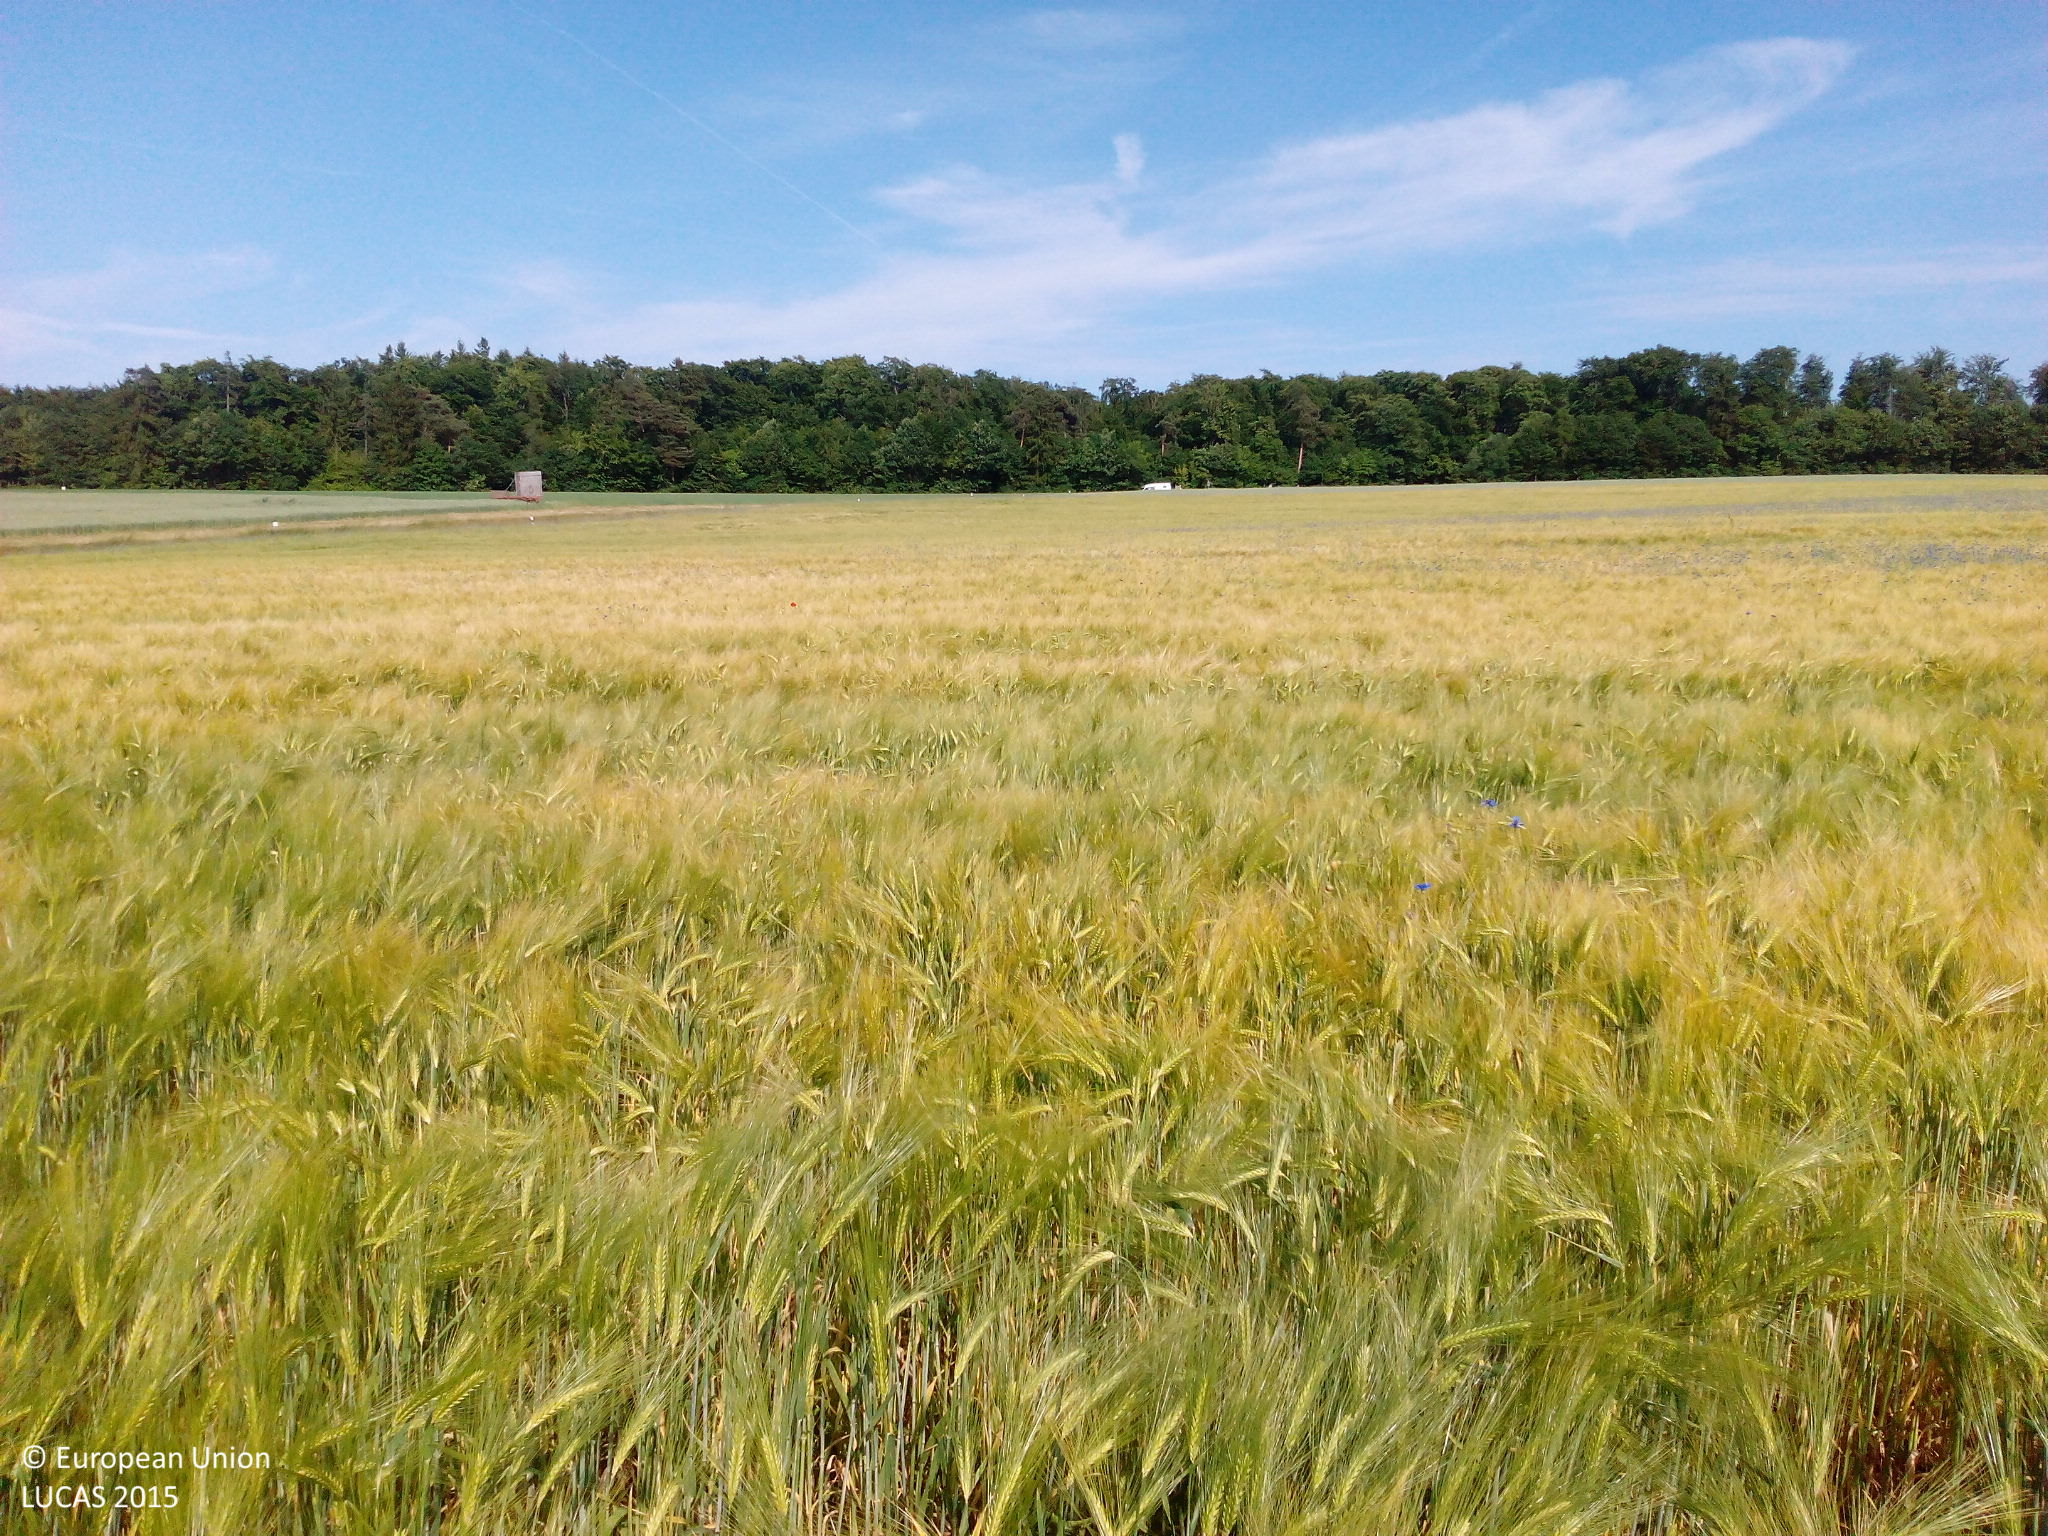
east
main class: Cropland
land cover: Barley
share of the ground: > 75 %
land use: Agriculture (excluding fallow land and kitchen gardens)
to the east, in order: Barley; Grass margins; Ditches and canals; Grass margins; Paved roads, cycling and walking lanes; Grass margins; Ditches and canals; Grass margins; Oats
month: June
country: DE
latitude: 50.1870
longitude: 8.1376
